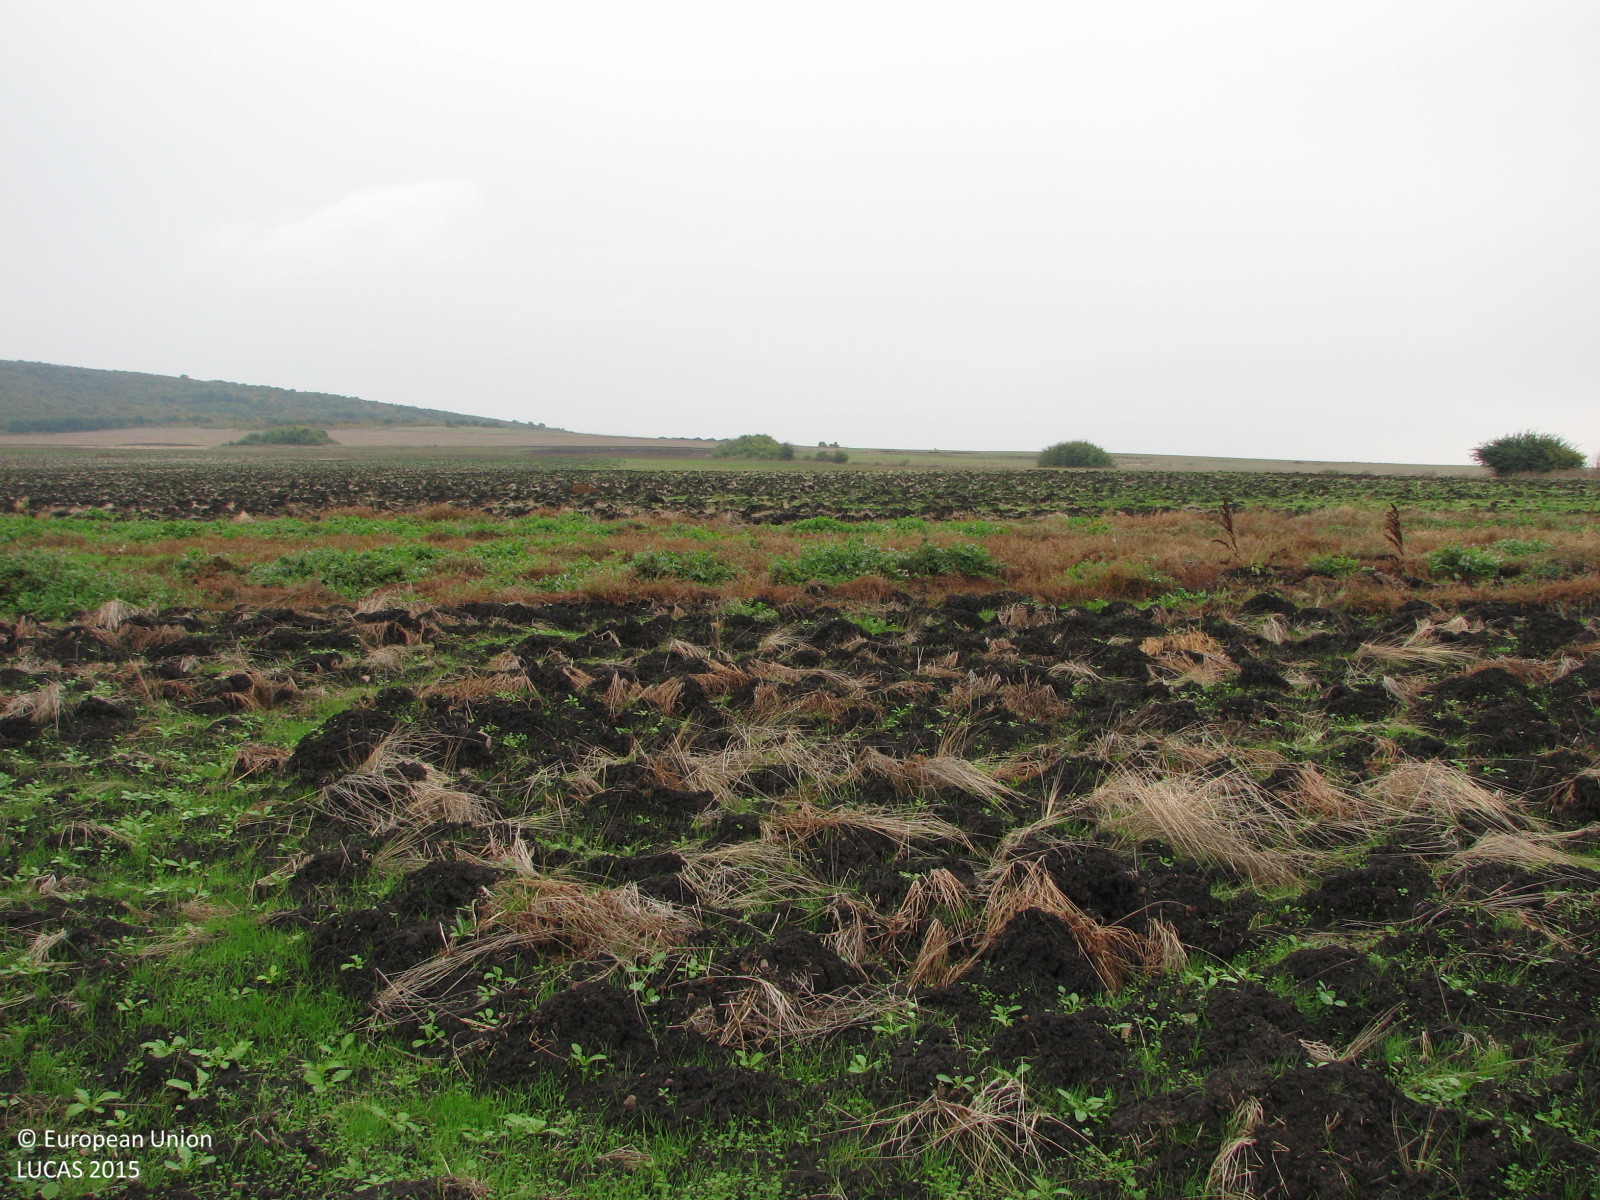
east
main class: Grassland
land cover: Spontaneously vegetated surfaces
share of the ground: 25 - 50 %
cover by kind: unconsolidated bare surface 70 %, herbaceous plants 30 %
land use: Agriculture (excluding fallow land and kitchen gardens)
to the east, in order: Spontaneously vegetated surfaces
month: October
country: BG
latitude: 42.3965
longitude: 26.7029
